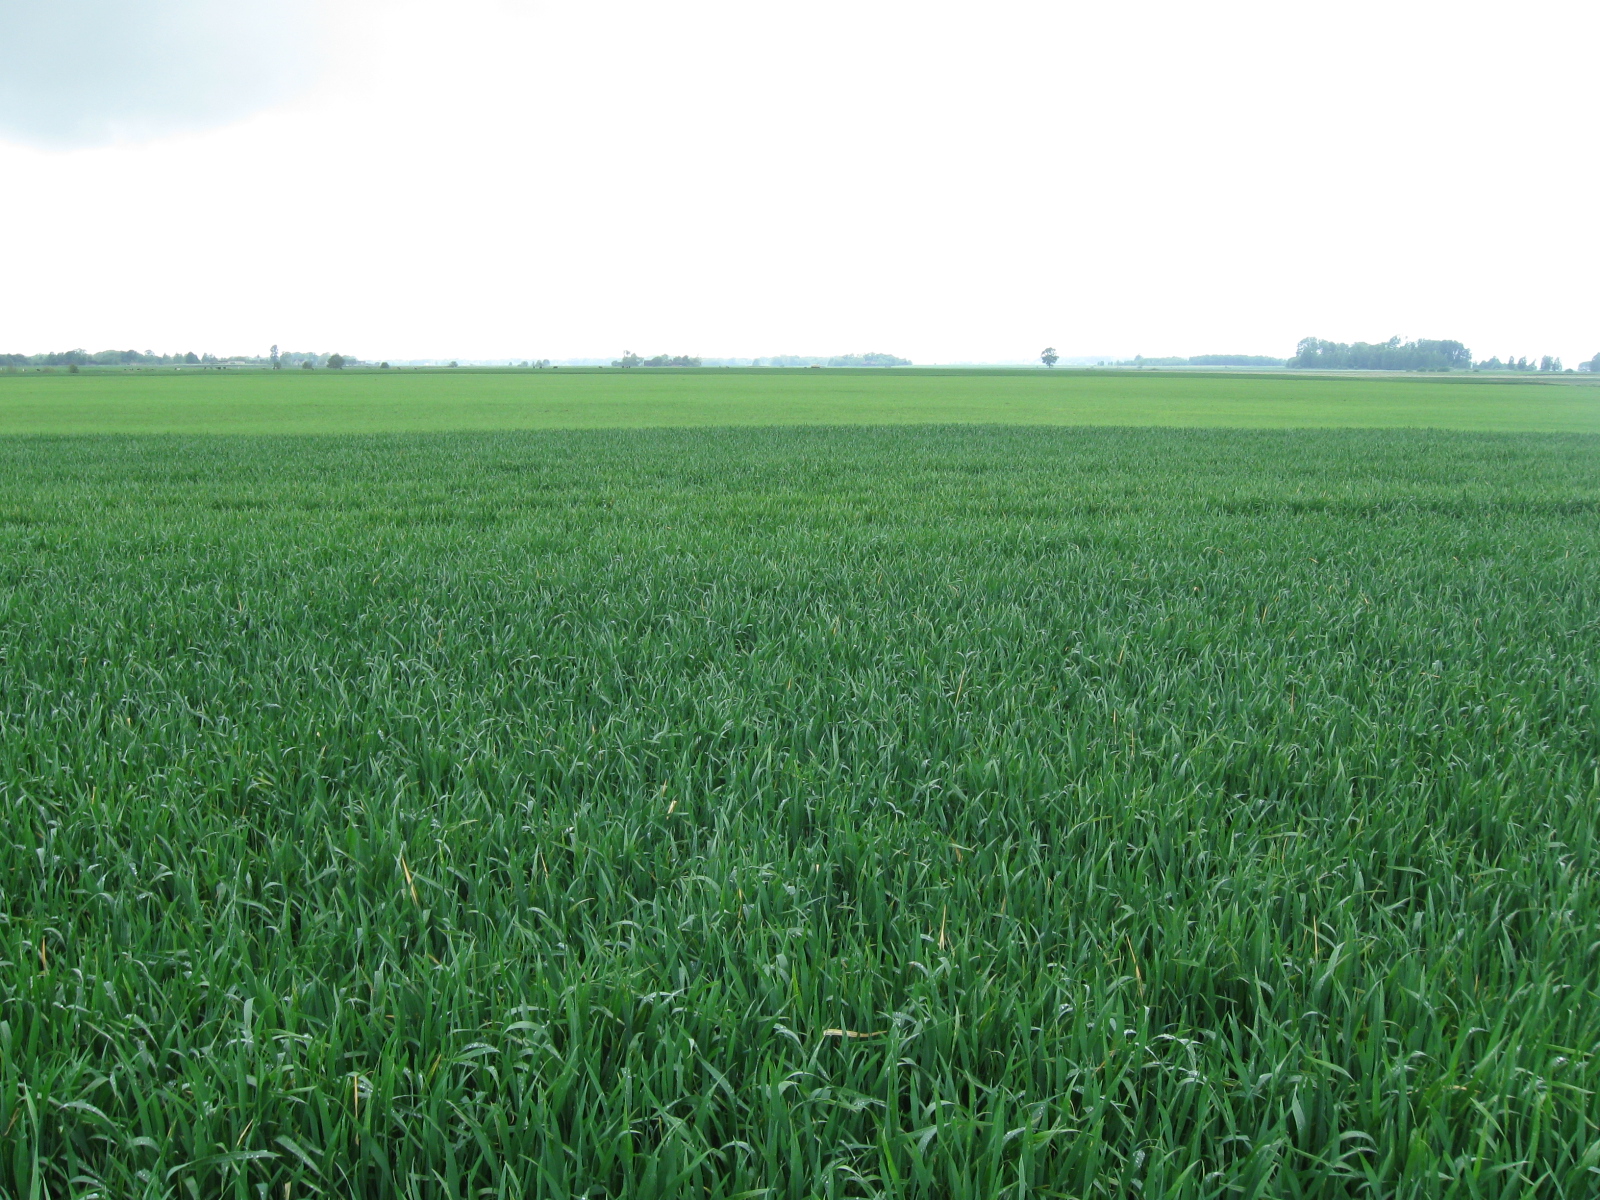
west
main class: Cropland
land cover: Common wheat
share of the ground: > 75 %
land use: Agriculture (excluding fallow land and kitchen gardens)
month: May
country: LT
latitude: 55.0278
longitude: 22.8495
